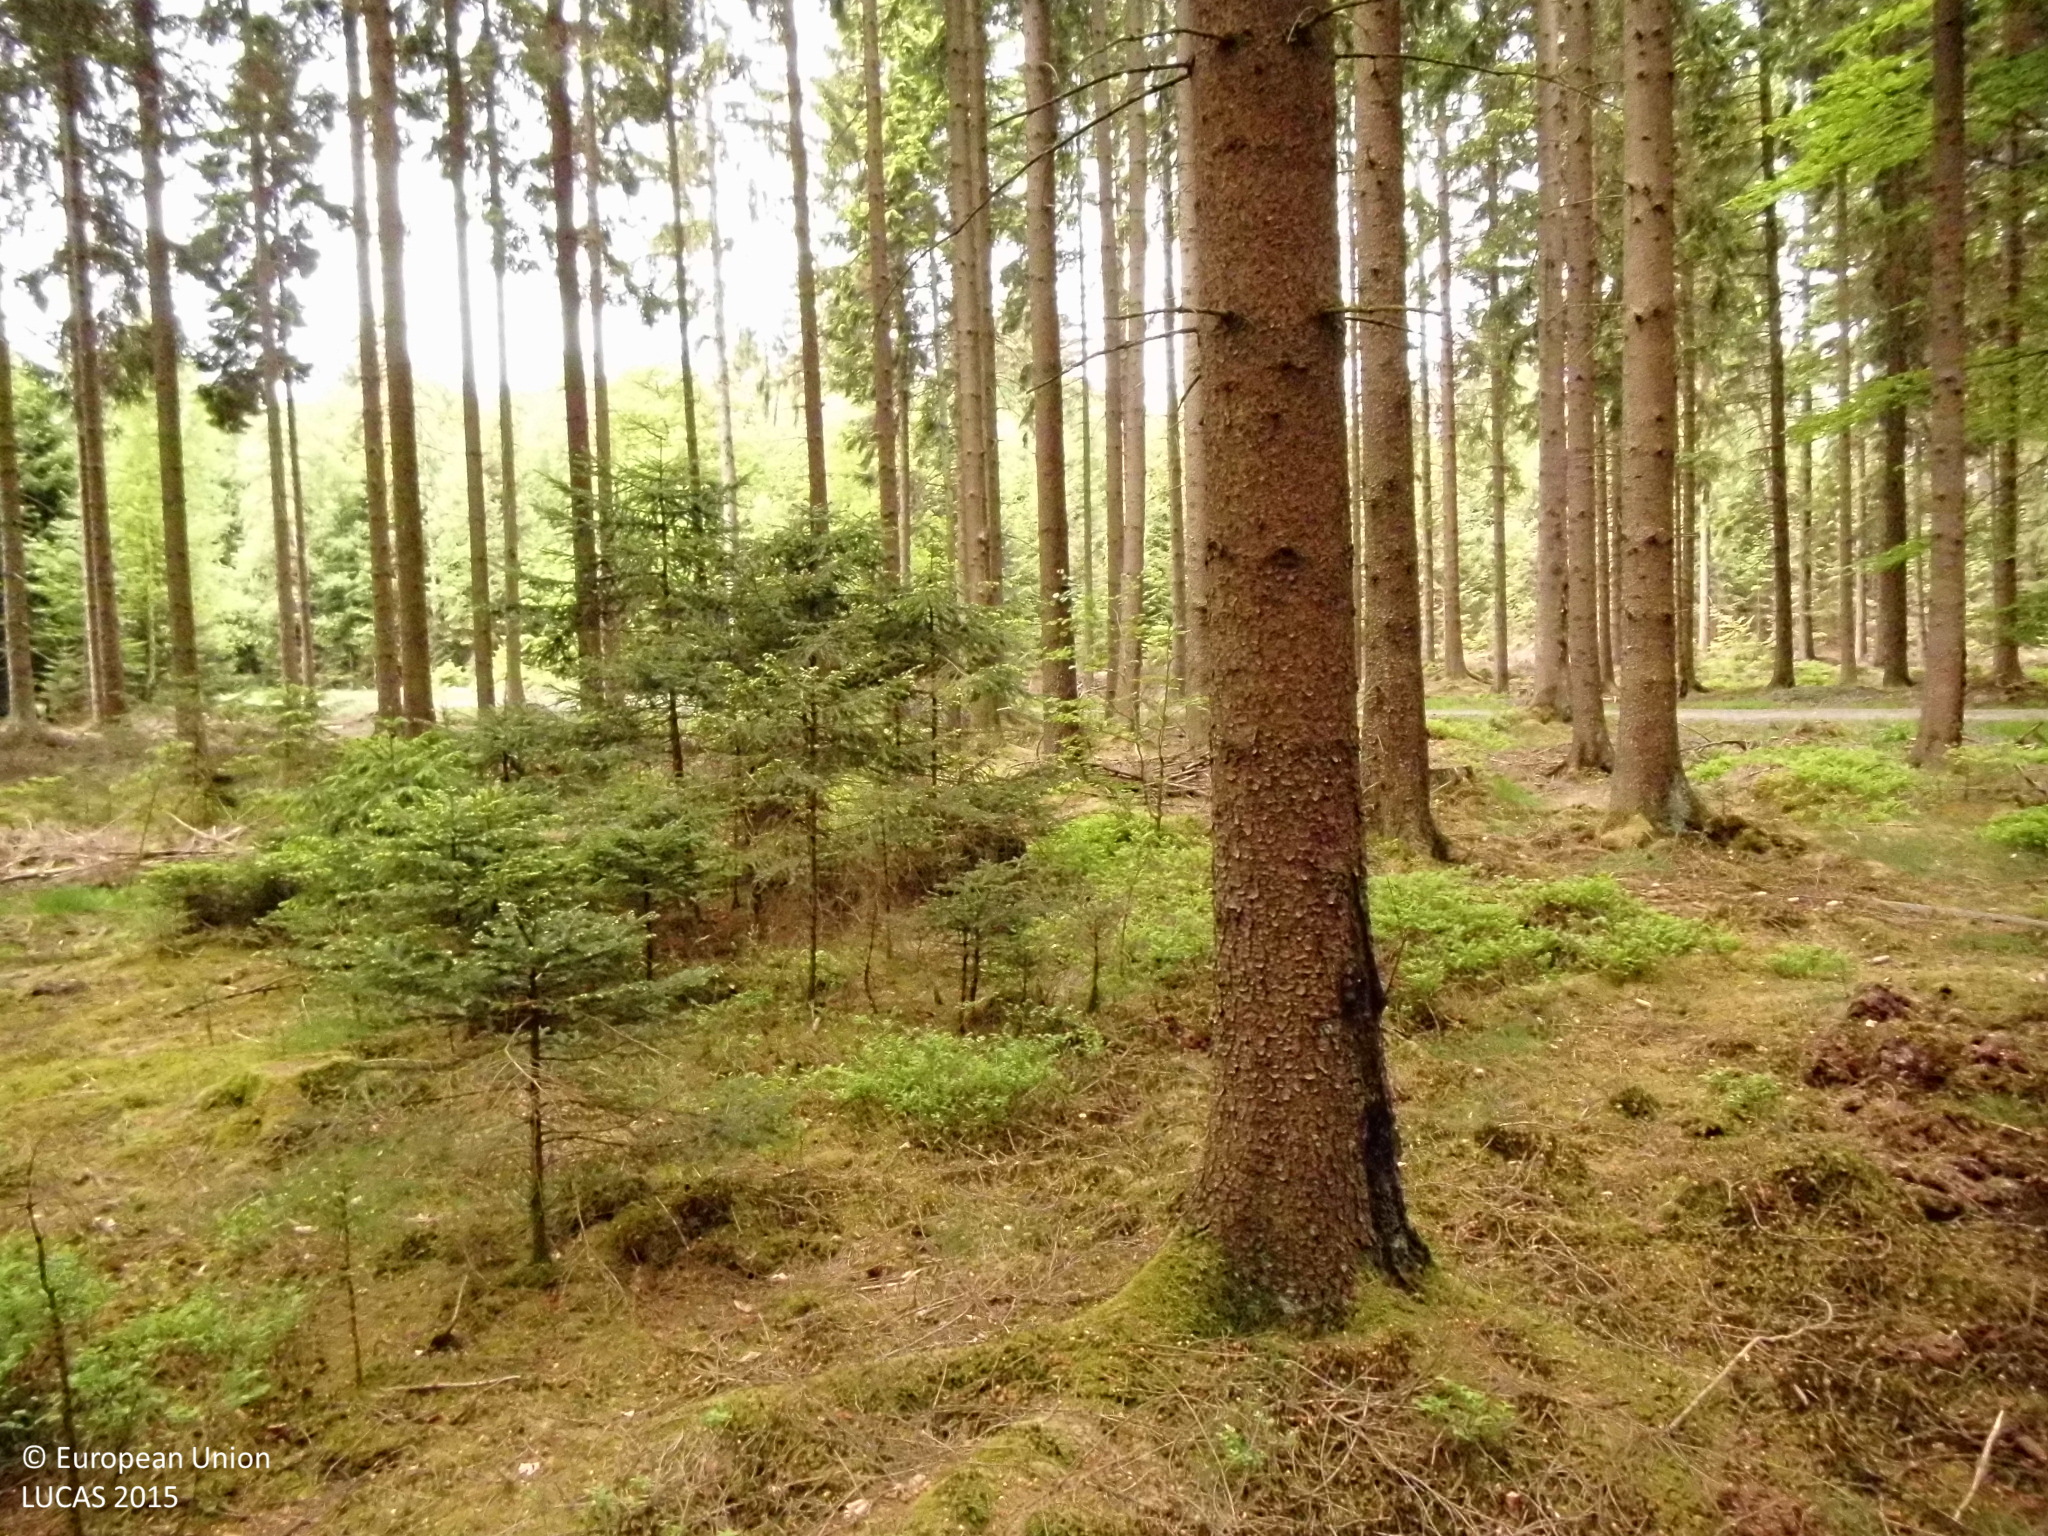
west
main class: Woodland
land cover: Spruce dominated coniferous woodland
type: hemiboreal forest and nemoral coniferous forest and mixed broadleaved-coniferous forest
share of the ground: > 75 %
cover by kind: coniferous forest trees 85 %, lichens and mosses 10 %, herbaceous plants 5 %
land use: Forestry
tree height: > 5 m
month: May
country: DE
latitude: 50.7330
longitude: 7.5208
